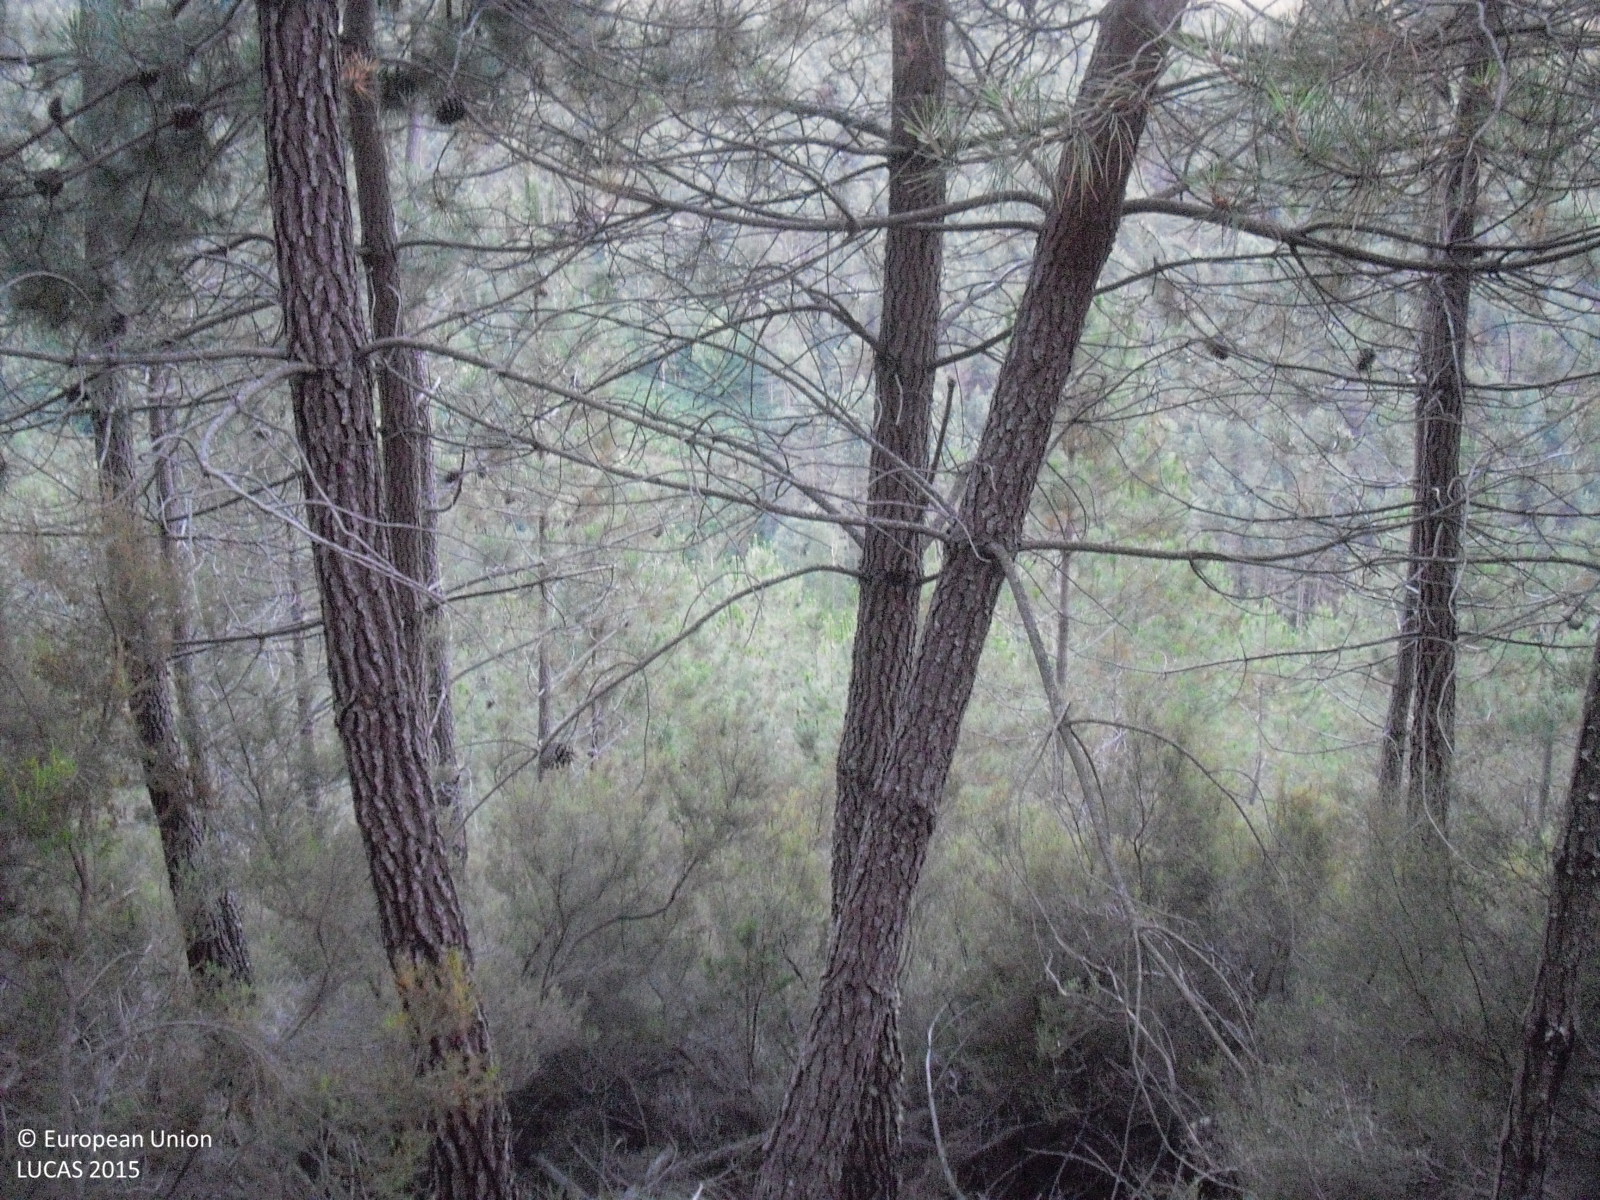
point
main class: Woodland
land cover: Pine dominated coniferous woodland
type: hemiboreal forest and nemoral coniferous forest and mixed broadleaved-coniferous forest
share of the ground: 50 - 75 %
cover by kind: coniferous forest trees 70 %, shrubs 30 %
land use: Forestry
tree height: > 5 m
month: July
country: ES
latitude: 42.5569
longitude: -7.2735
